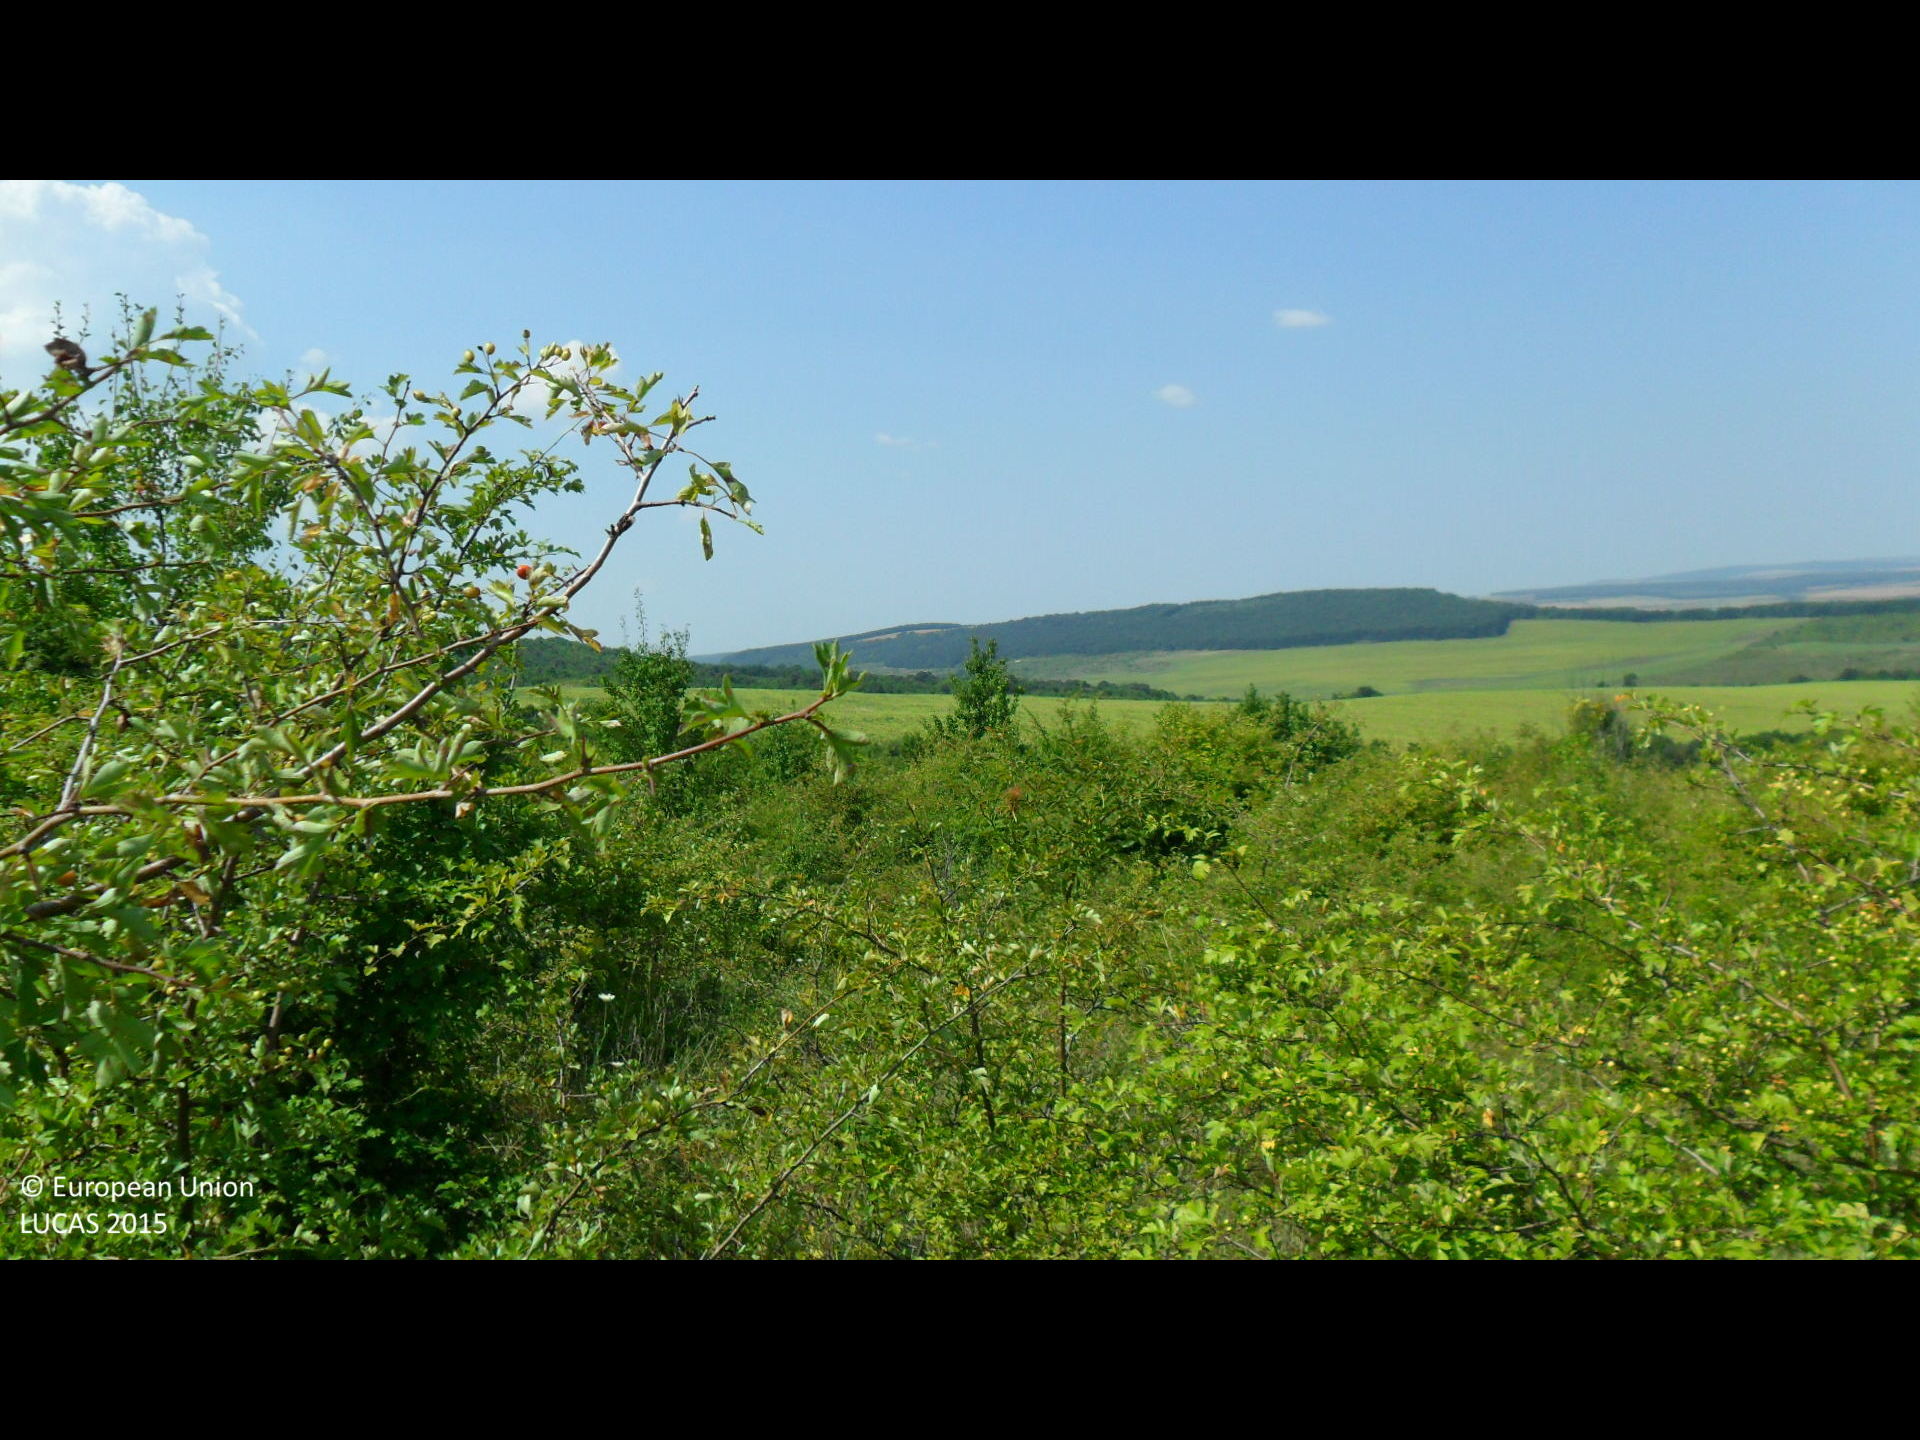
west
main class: Shrubland
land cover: Shrubland with sparse tree cover
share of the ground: > 75 %
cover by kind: shrubs 90 %, broadleaved forest trees 5 %, herbaceous plants 5 %
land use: Semi-natural and natural areas not in use
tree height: < 5 m
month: August
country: BG
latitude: 43.2854
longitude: 26.3285
